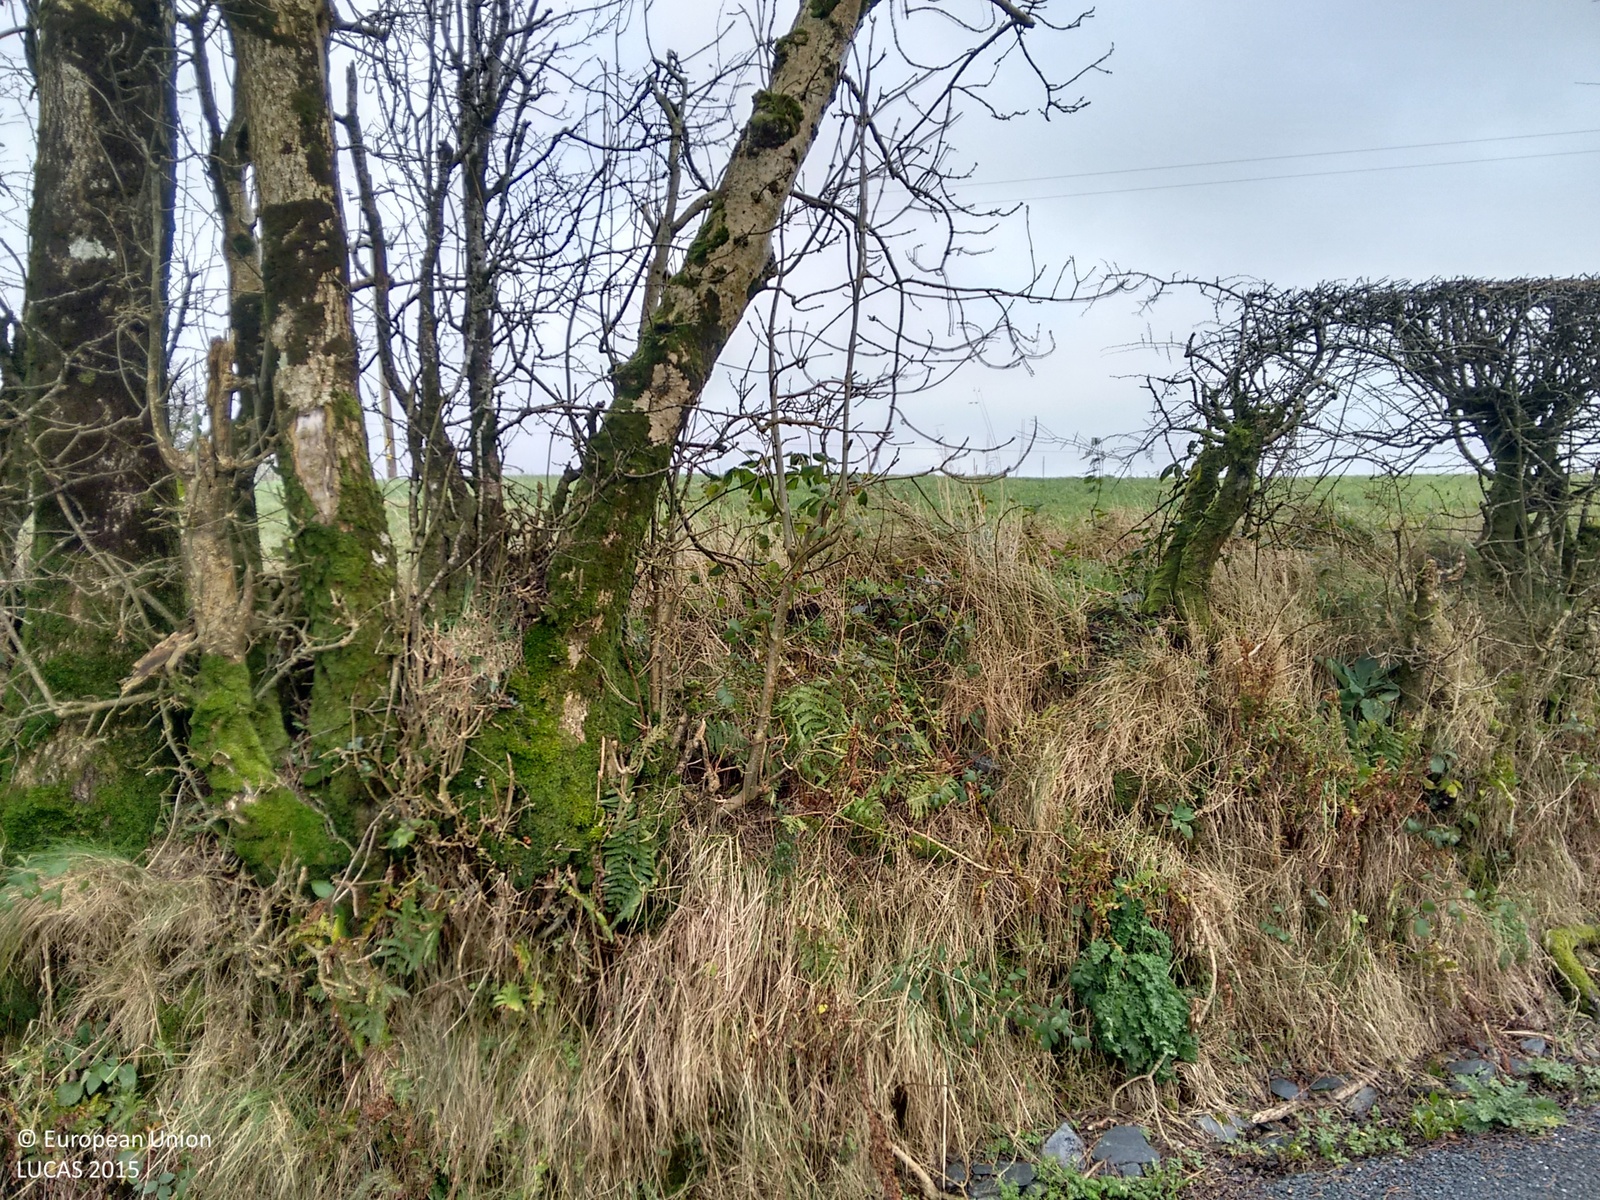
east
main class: Grassland
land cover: Grassland without tree/shrub cover
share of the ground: > 75 %
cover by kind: herbaceous plants 100 %
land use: Agriculture (excluding fallow land and kitchen gardens)
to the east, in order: Grassland without tree/shrub cover; Abandoned hedges; Grassland without tree/shrub cover; Abandoned hedges; Grassland without tree/shrub cover; Abandoned hedges; Grassland without tree/shrub cover
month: December
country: IE
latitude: 54.0602
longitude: -6.8972
